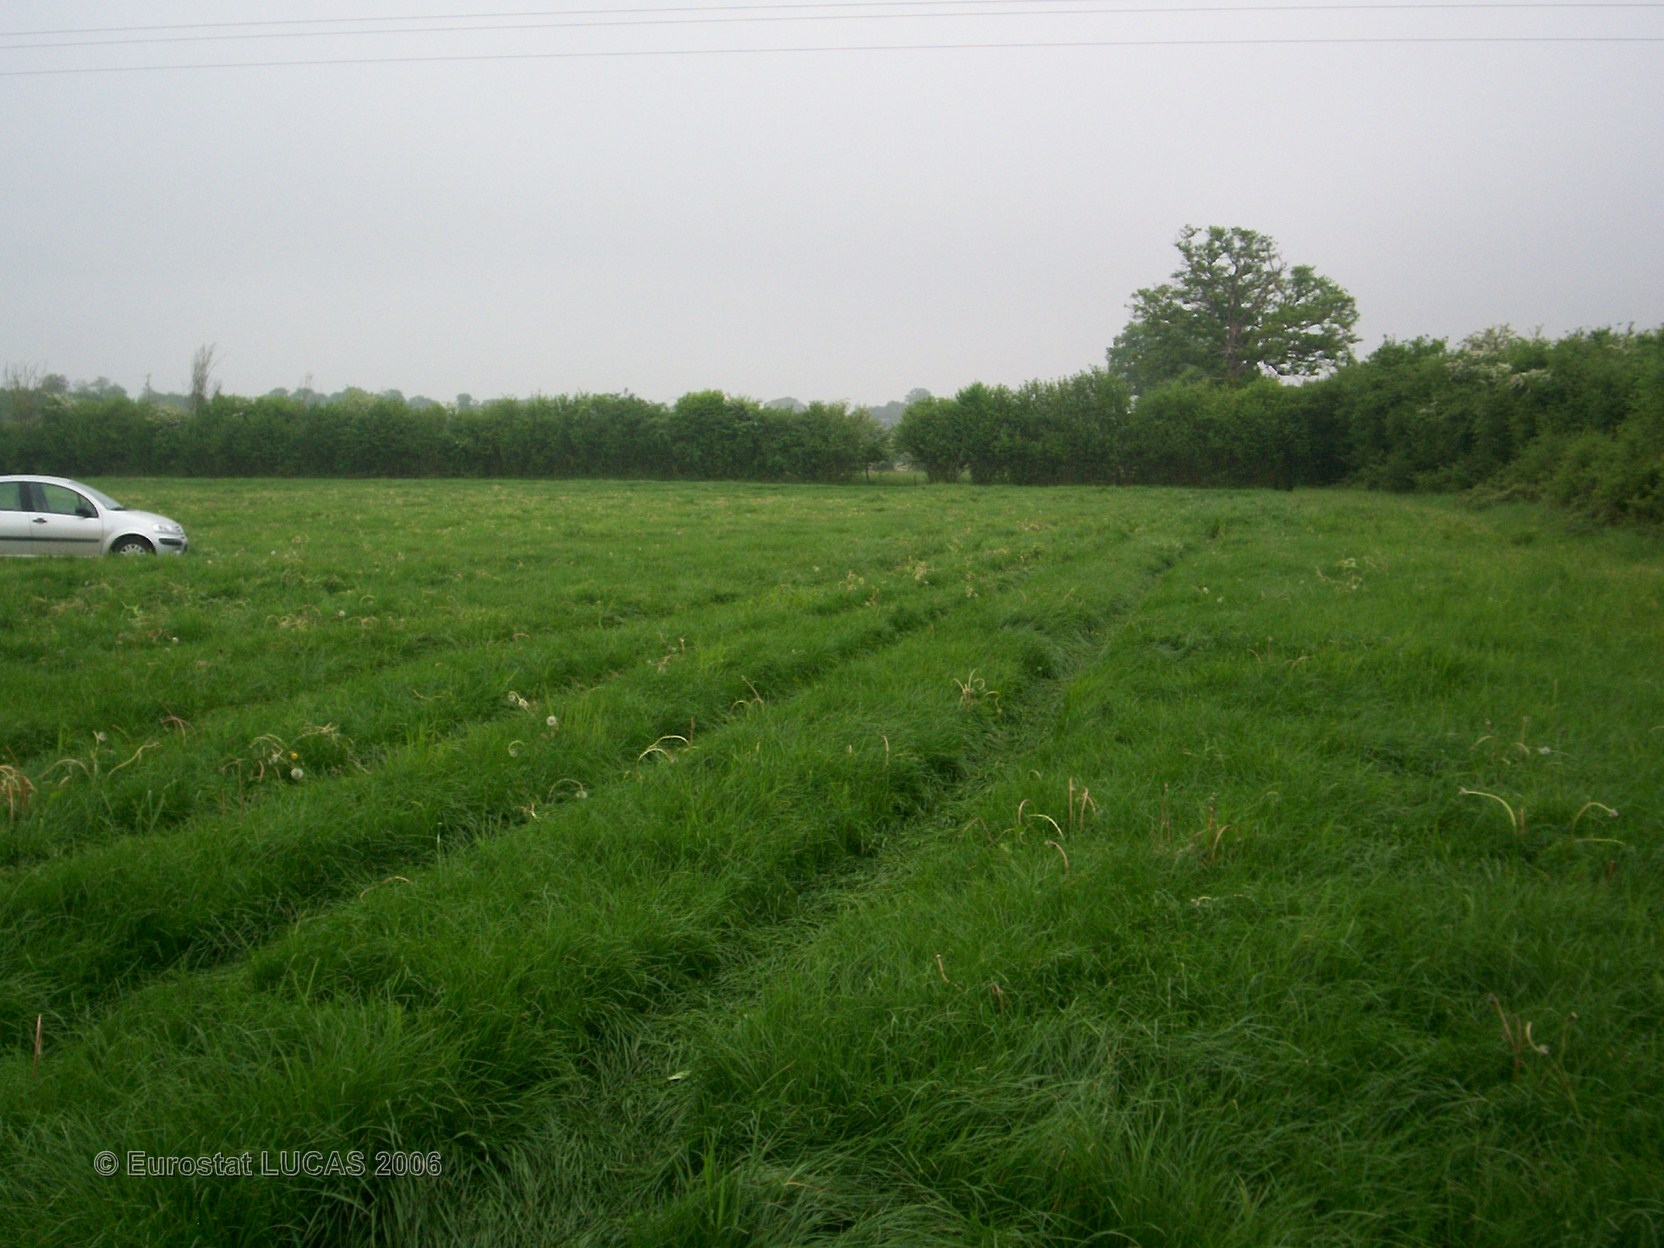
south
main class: Grassland
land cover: Grassland without tree/shrub cover
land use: Agriculture (excluding fallow land and kitchen gardens)
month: May
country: FR
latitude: 47.9489
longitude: 0.4026
